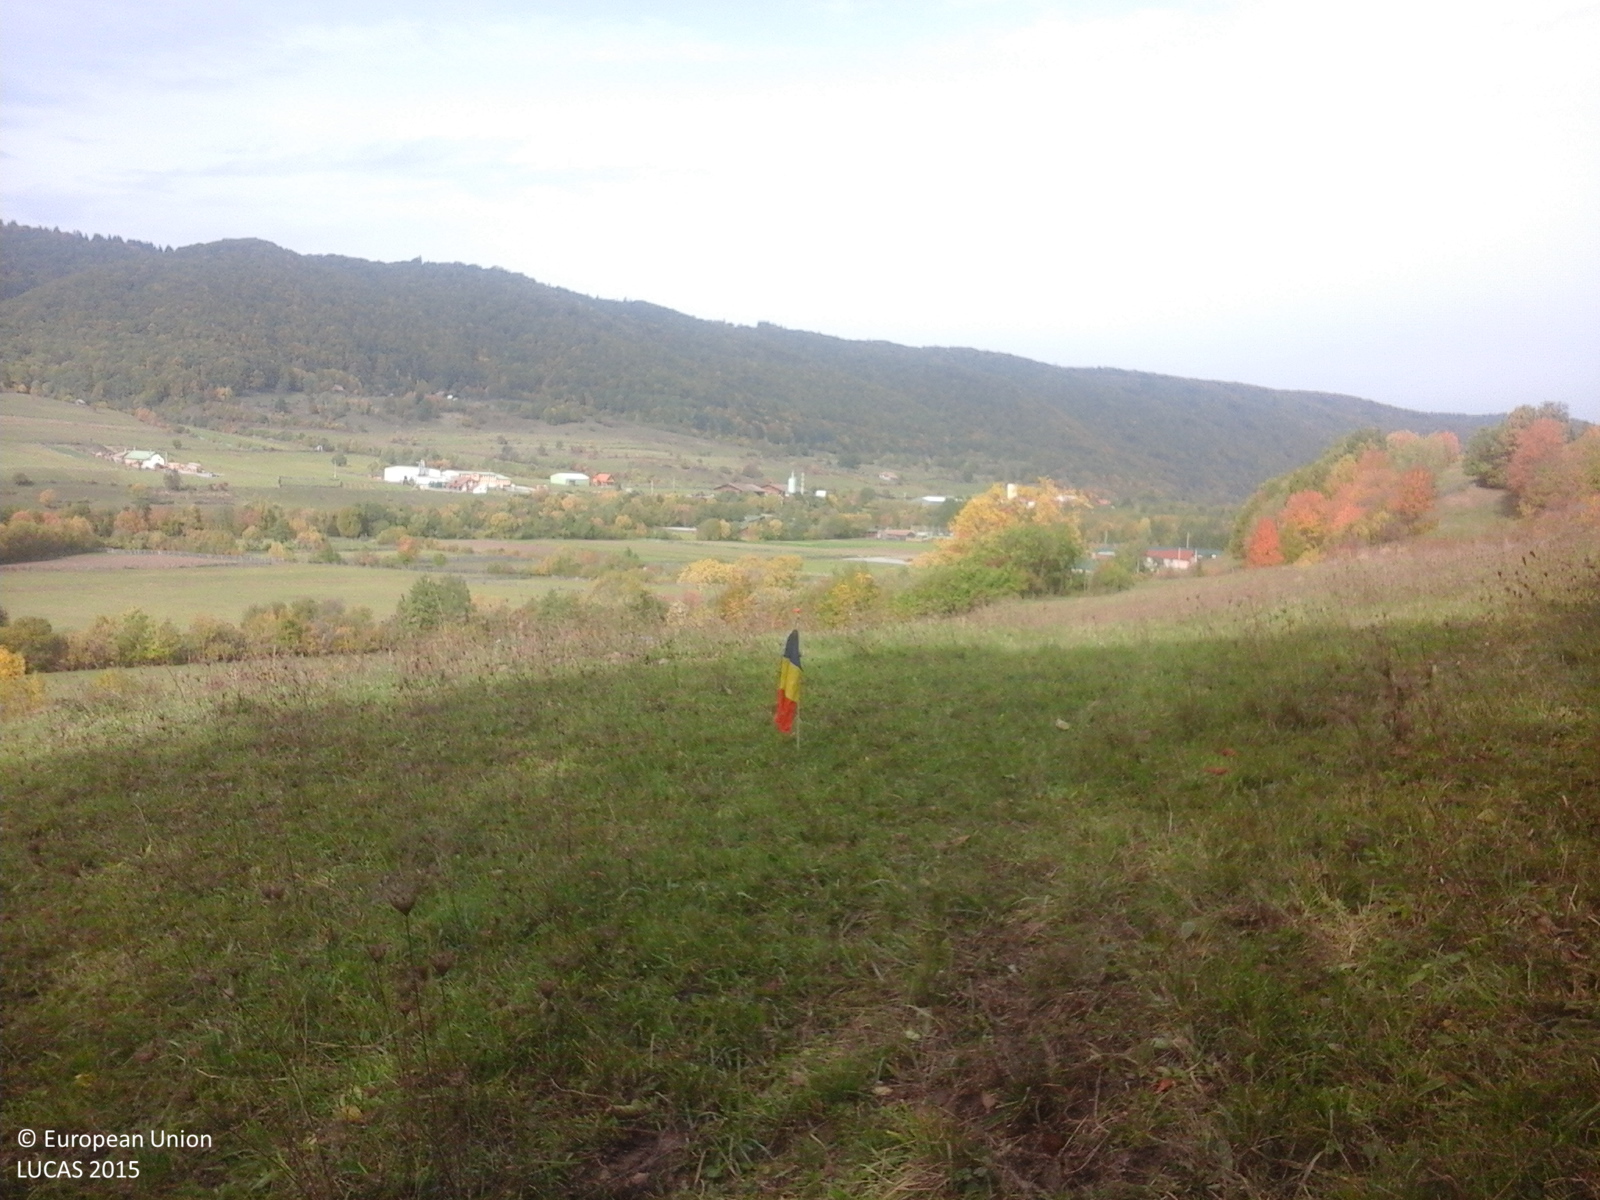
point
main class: Grassland
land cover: Grassland without tree/shrub cover
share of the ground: > 75 %
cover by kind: herbaceous plants 100 %
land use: Agriculture (excluding fallow land and kitchen gardens)
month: October
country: RO
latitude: 46.4194
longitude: 25.3937
